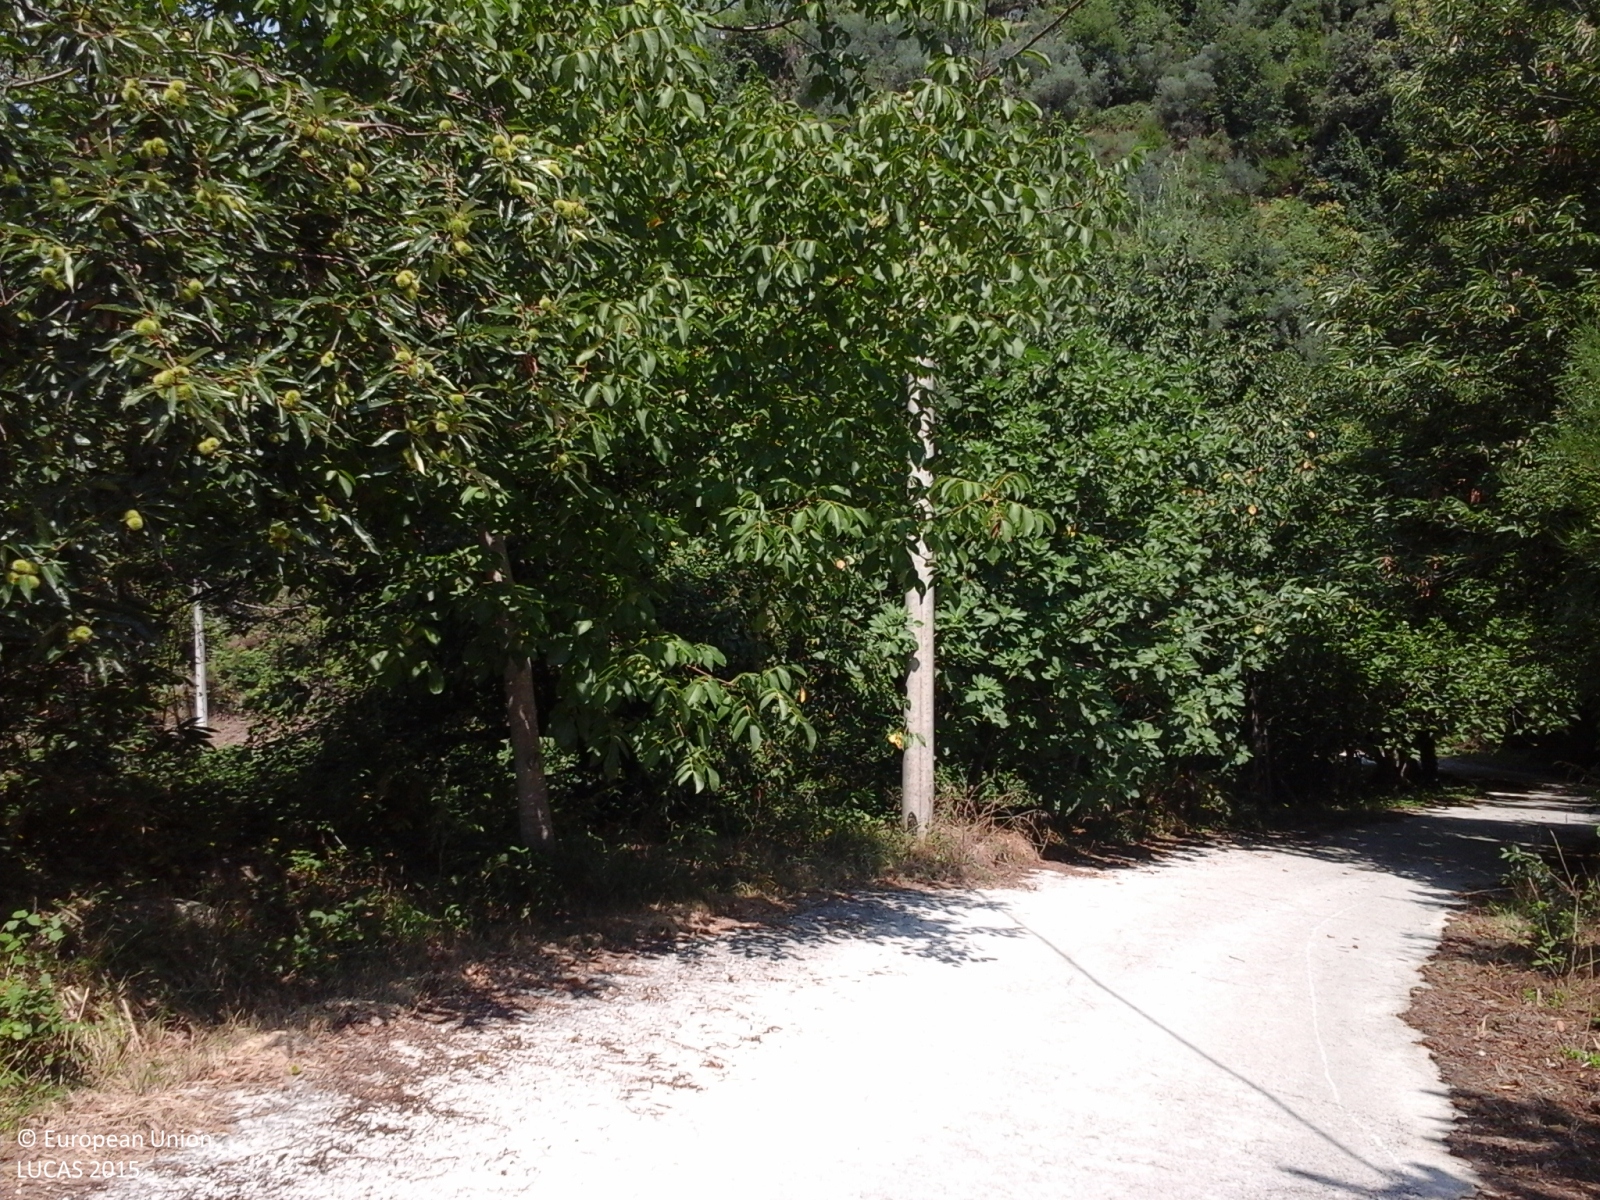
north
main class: Woodland
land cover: Broadleaved woodland
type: mesophytic deciduous forest
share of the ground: > 75 %
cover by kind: broadleaved forest trees 100 %
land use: Forestry
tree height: < 5 m
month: August
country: IT
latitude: 41.8861
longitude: 13.0139
